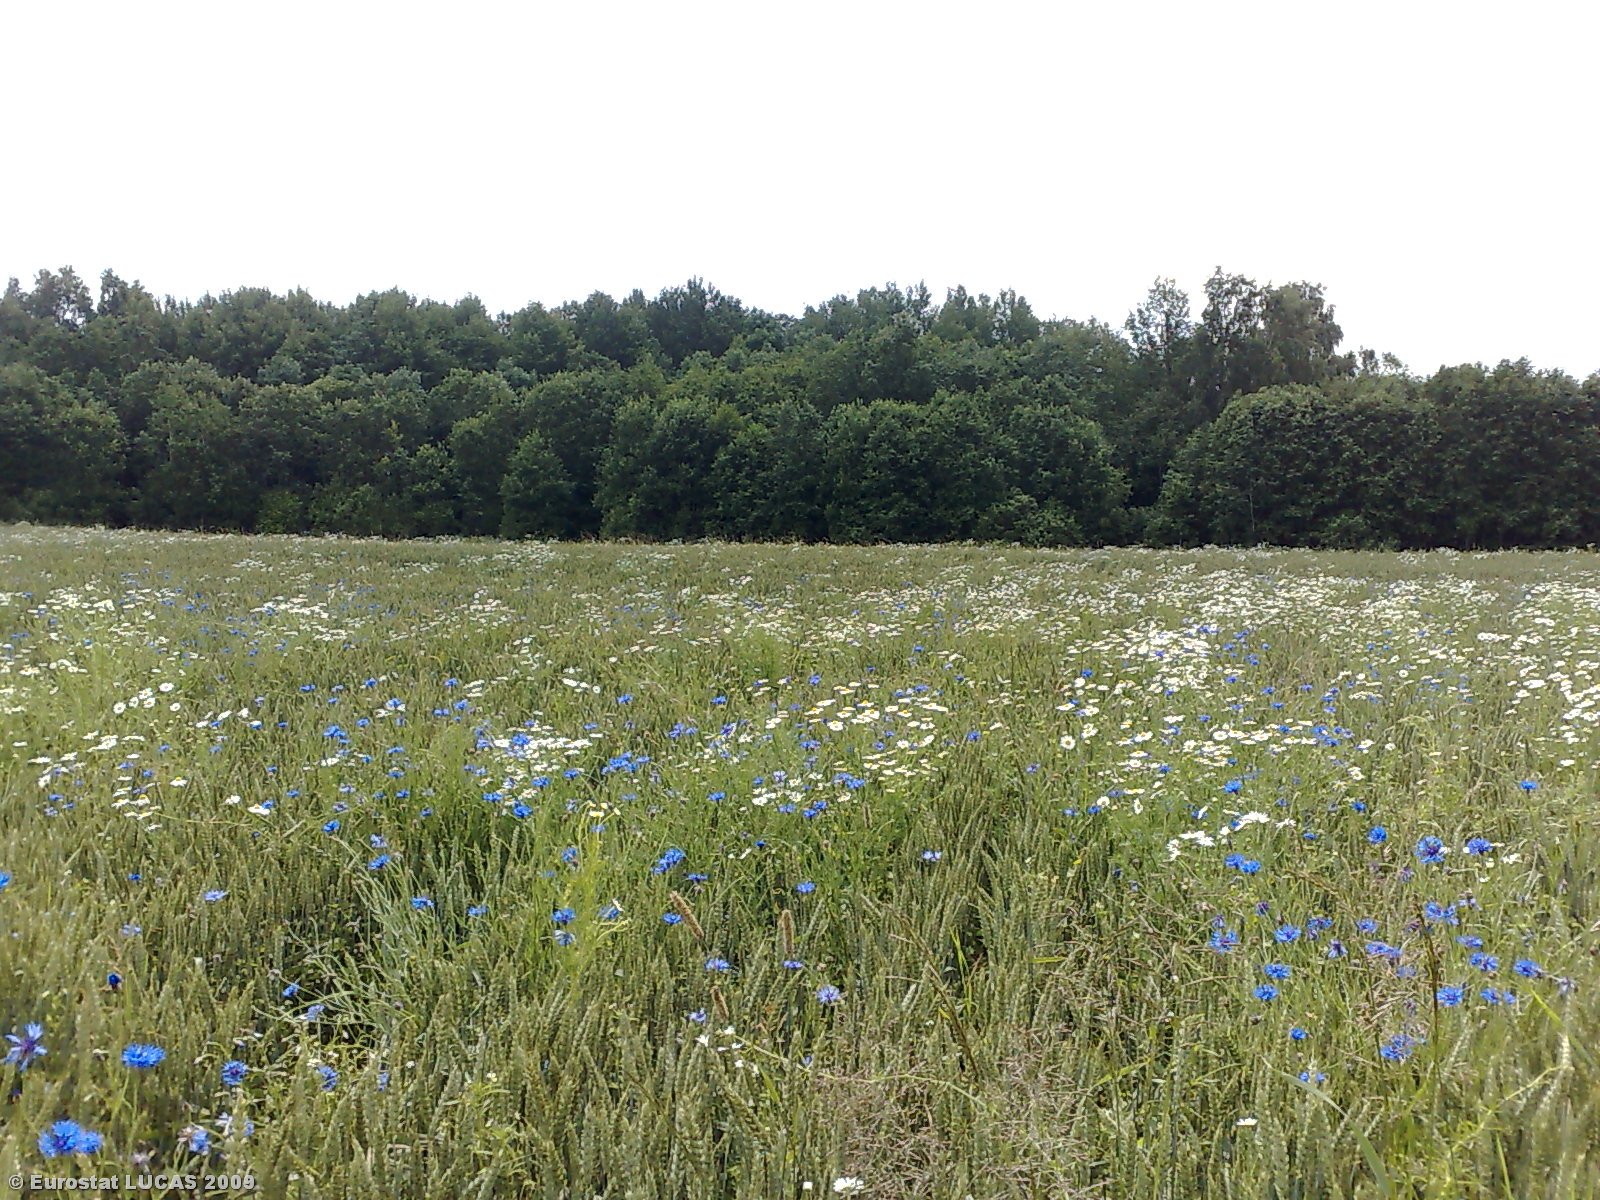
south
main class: Cropland
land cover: Common wheat
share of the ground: > 75 %
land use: Agriculture (excluding fallow land and kitchen gardens)
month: July
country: LT
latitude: 55.6179
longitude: 22.7839
